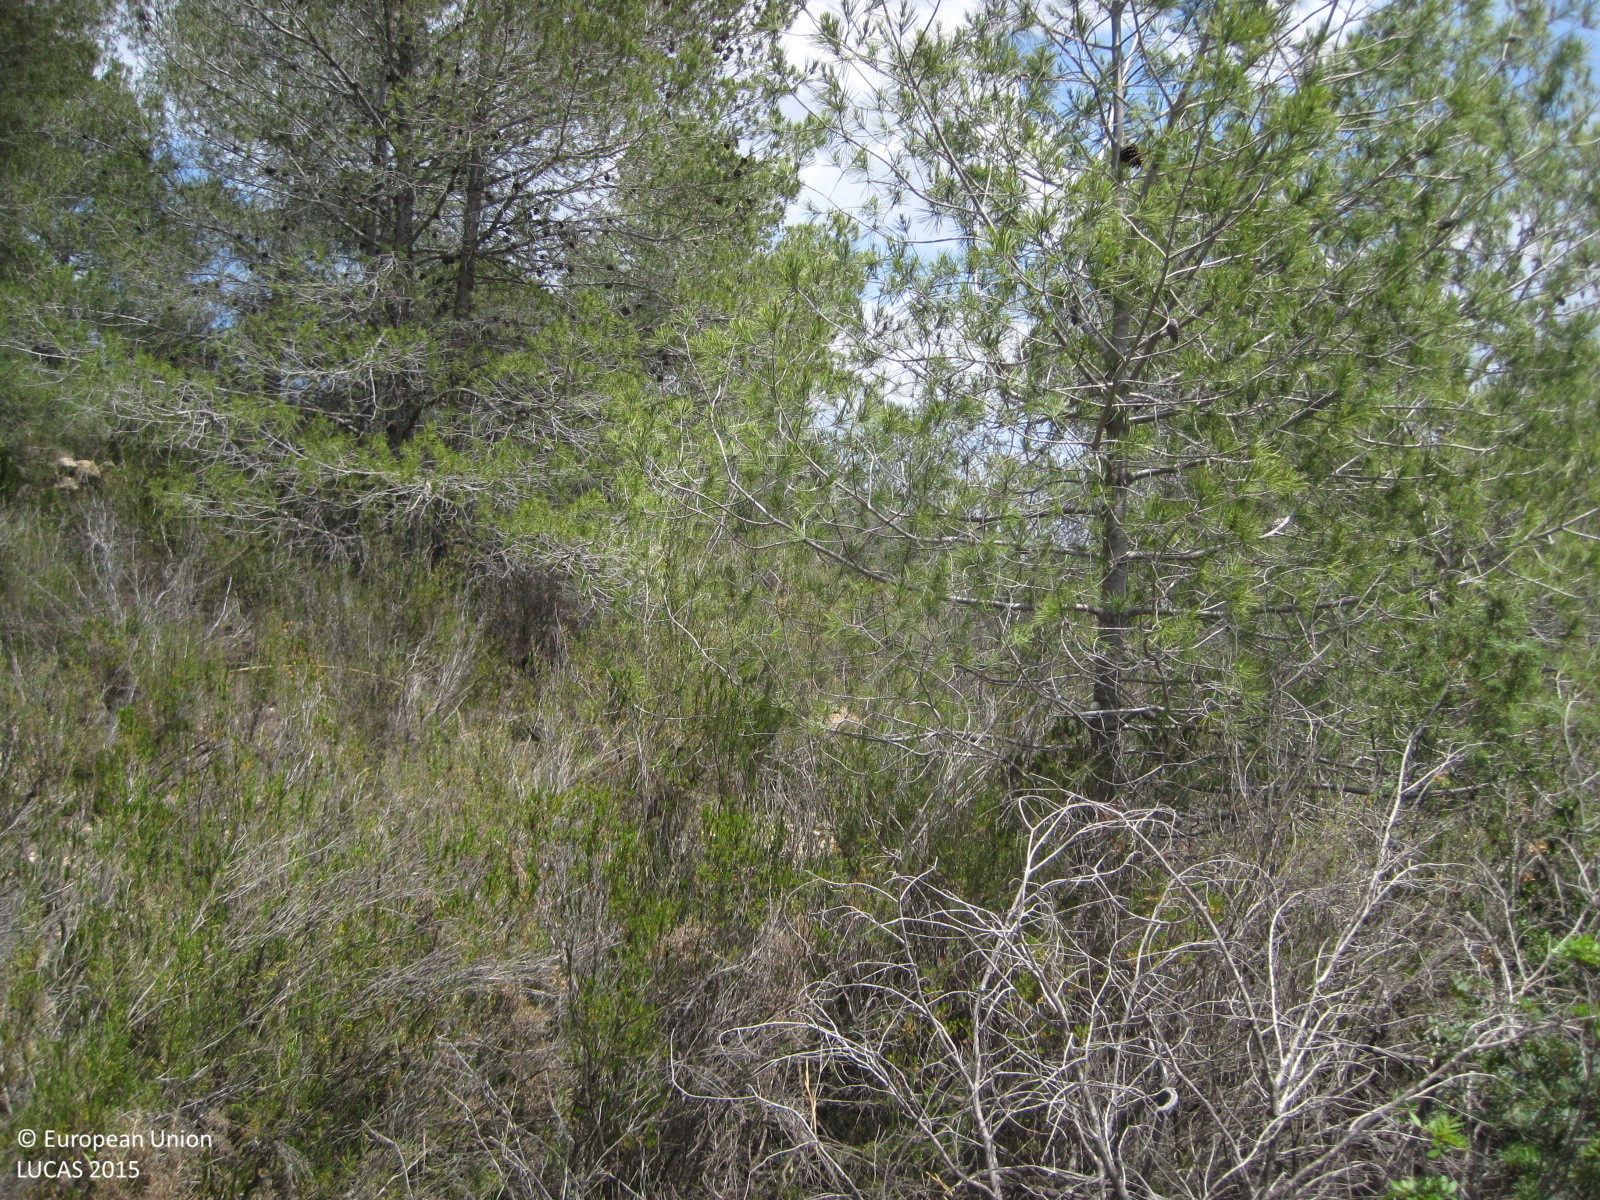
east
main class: Woodland
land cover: Pine dominated coniferous woodland
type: coniferous forest of the mediterranean region
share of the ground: 25 - 50 %
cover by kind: shrubs 40 %, coniferous forest trees 35 %, herbaceous plants 20 %, consolidated bare surface 5 %
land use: Semi-natural and natural areas not in use
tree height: > 5 m
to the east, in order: Pine dominated coniferous woodland; Dry stone walls; Pine dominated coniferous woodland; Dry stone walls; Pine dominated coniferous woodland; Dry stone walls; Shrubland with sparse tree cover; Dry stone walls; Shrubland with sparse tree cover; Dry stone walls; Pine dominated coniferous woodland
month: June
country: ES
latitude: 39.2717
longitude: -0.6021
